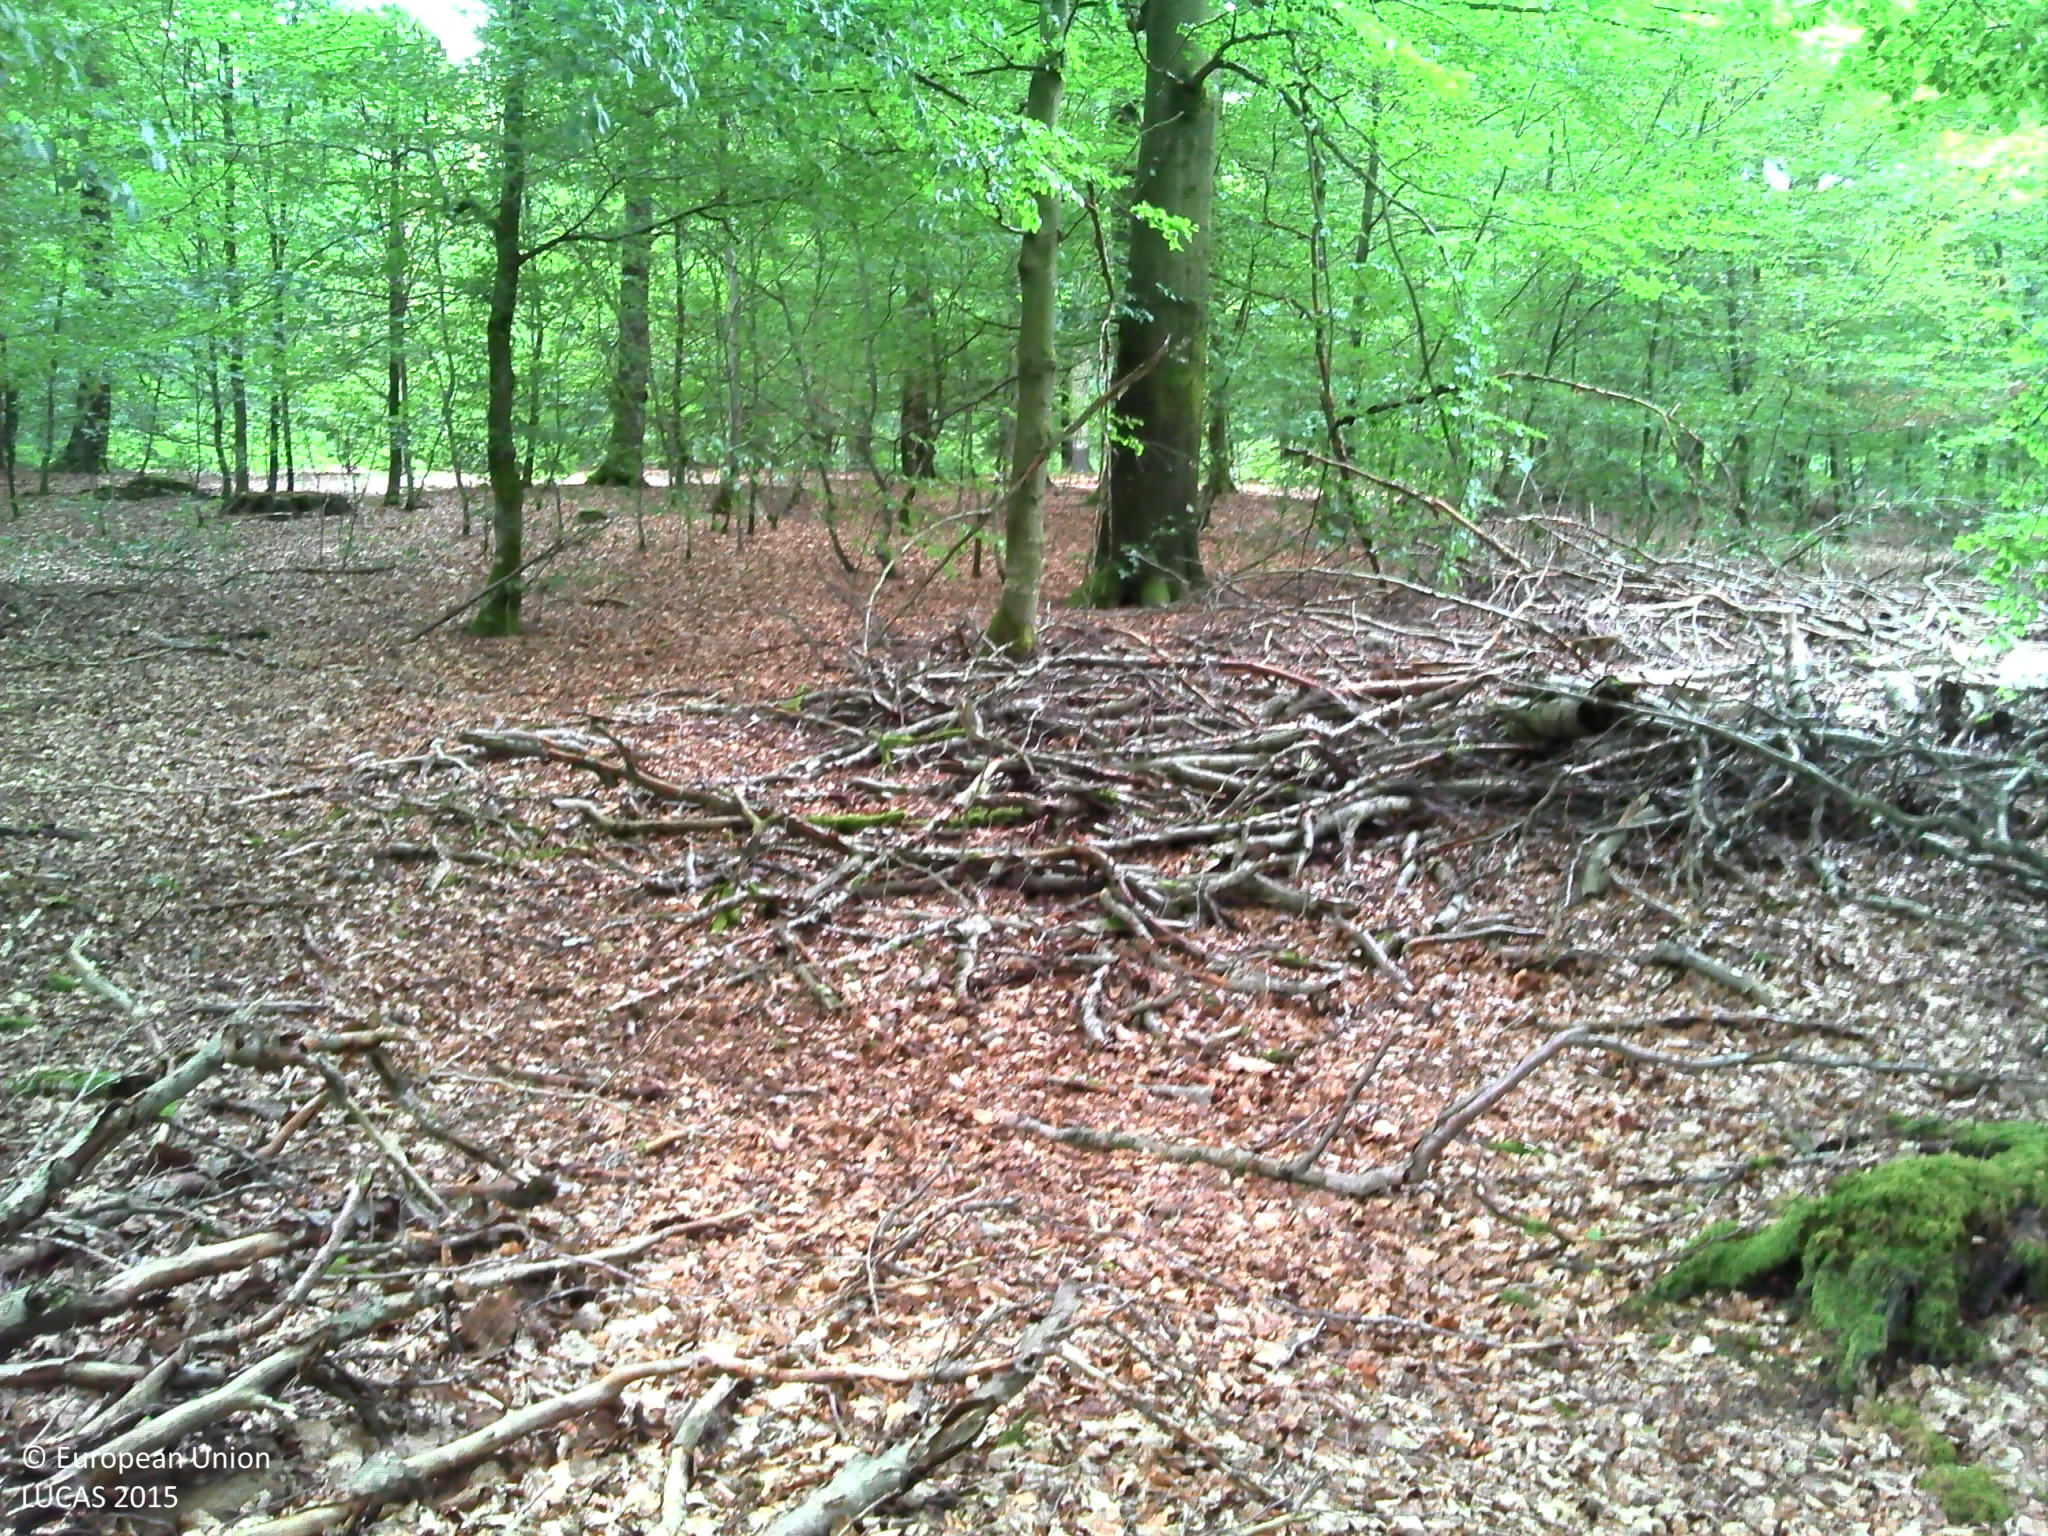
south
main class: Woodland
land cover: Broadleaved woodland
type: beech forest
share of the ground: > 75 %
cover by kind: broadleaved forest trees 90 %, unconsolidated bare surface 10 %
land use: Forestry
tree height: > 5 m
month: July
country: BE
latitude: 49.7783
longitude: 5.6798
